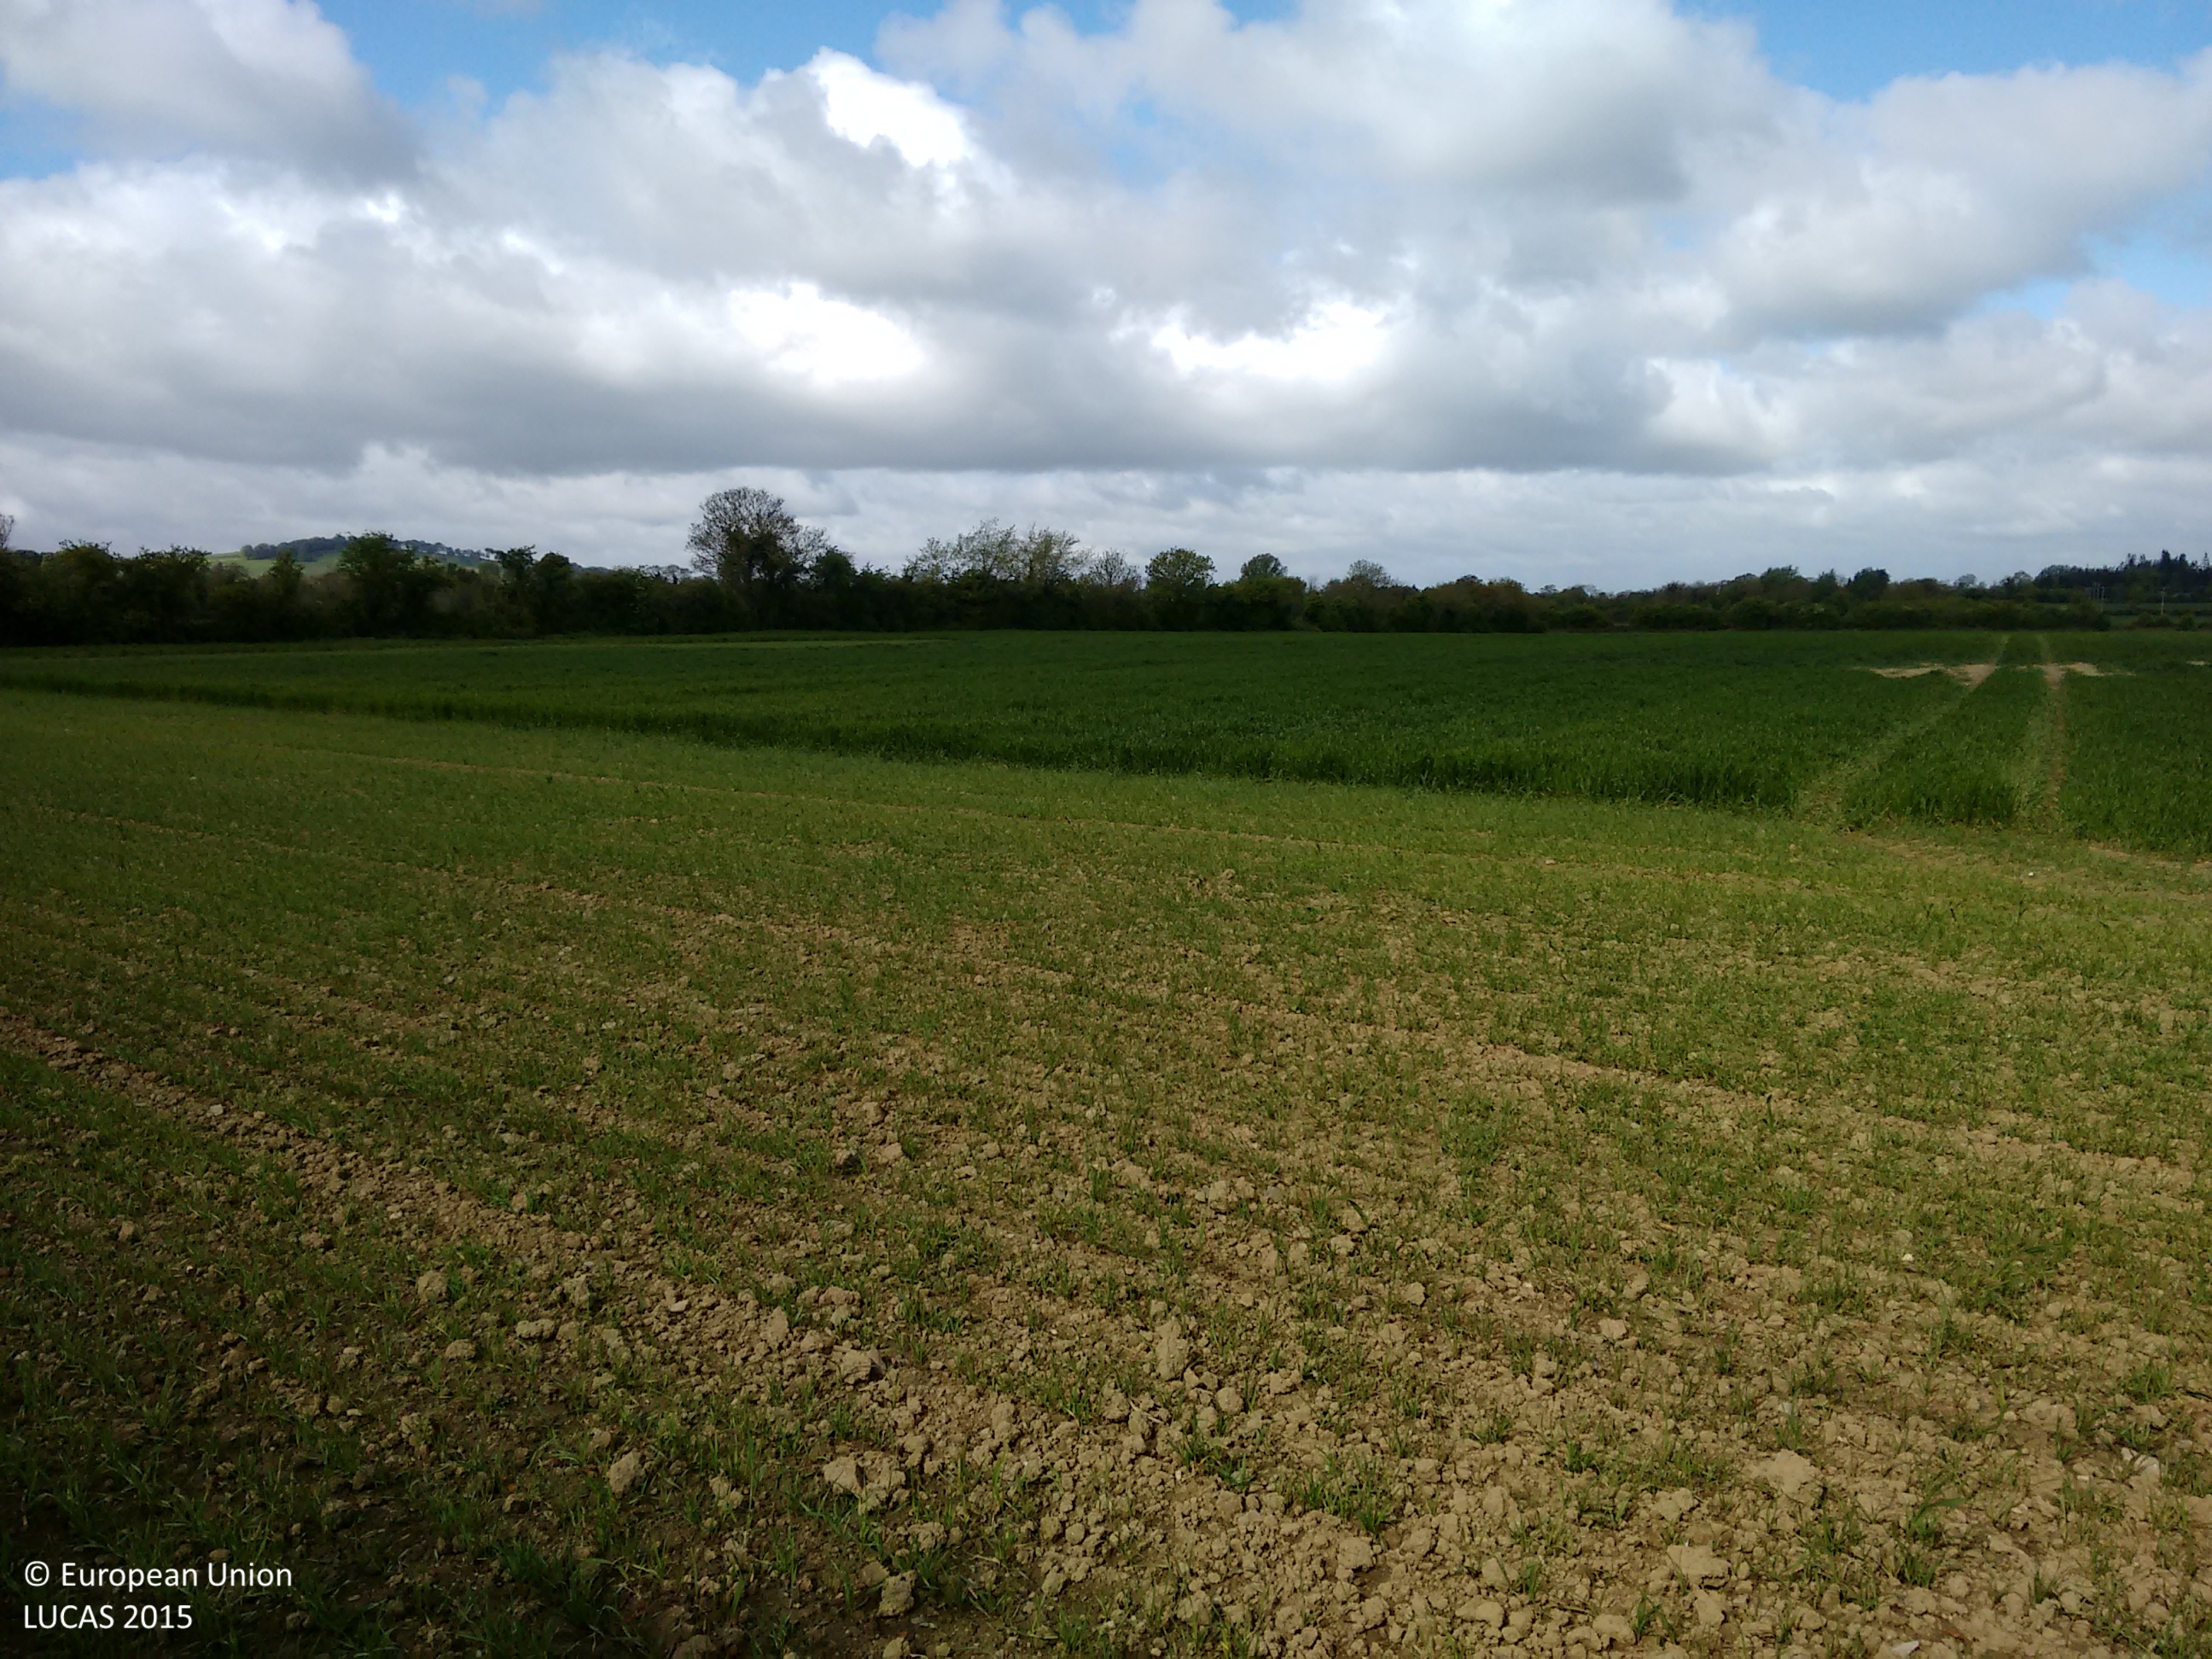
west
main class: Cropland
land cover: Barley
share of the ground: 50 - 75 %
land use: Agriculture (excluding fallow land and kitchen gardens)
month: May
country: IE
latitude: 53.3061
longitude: -6.4996
